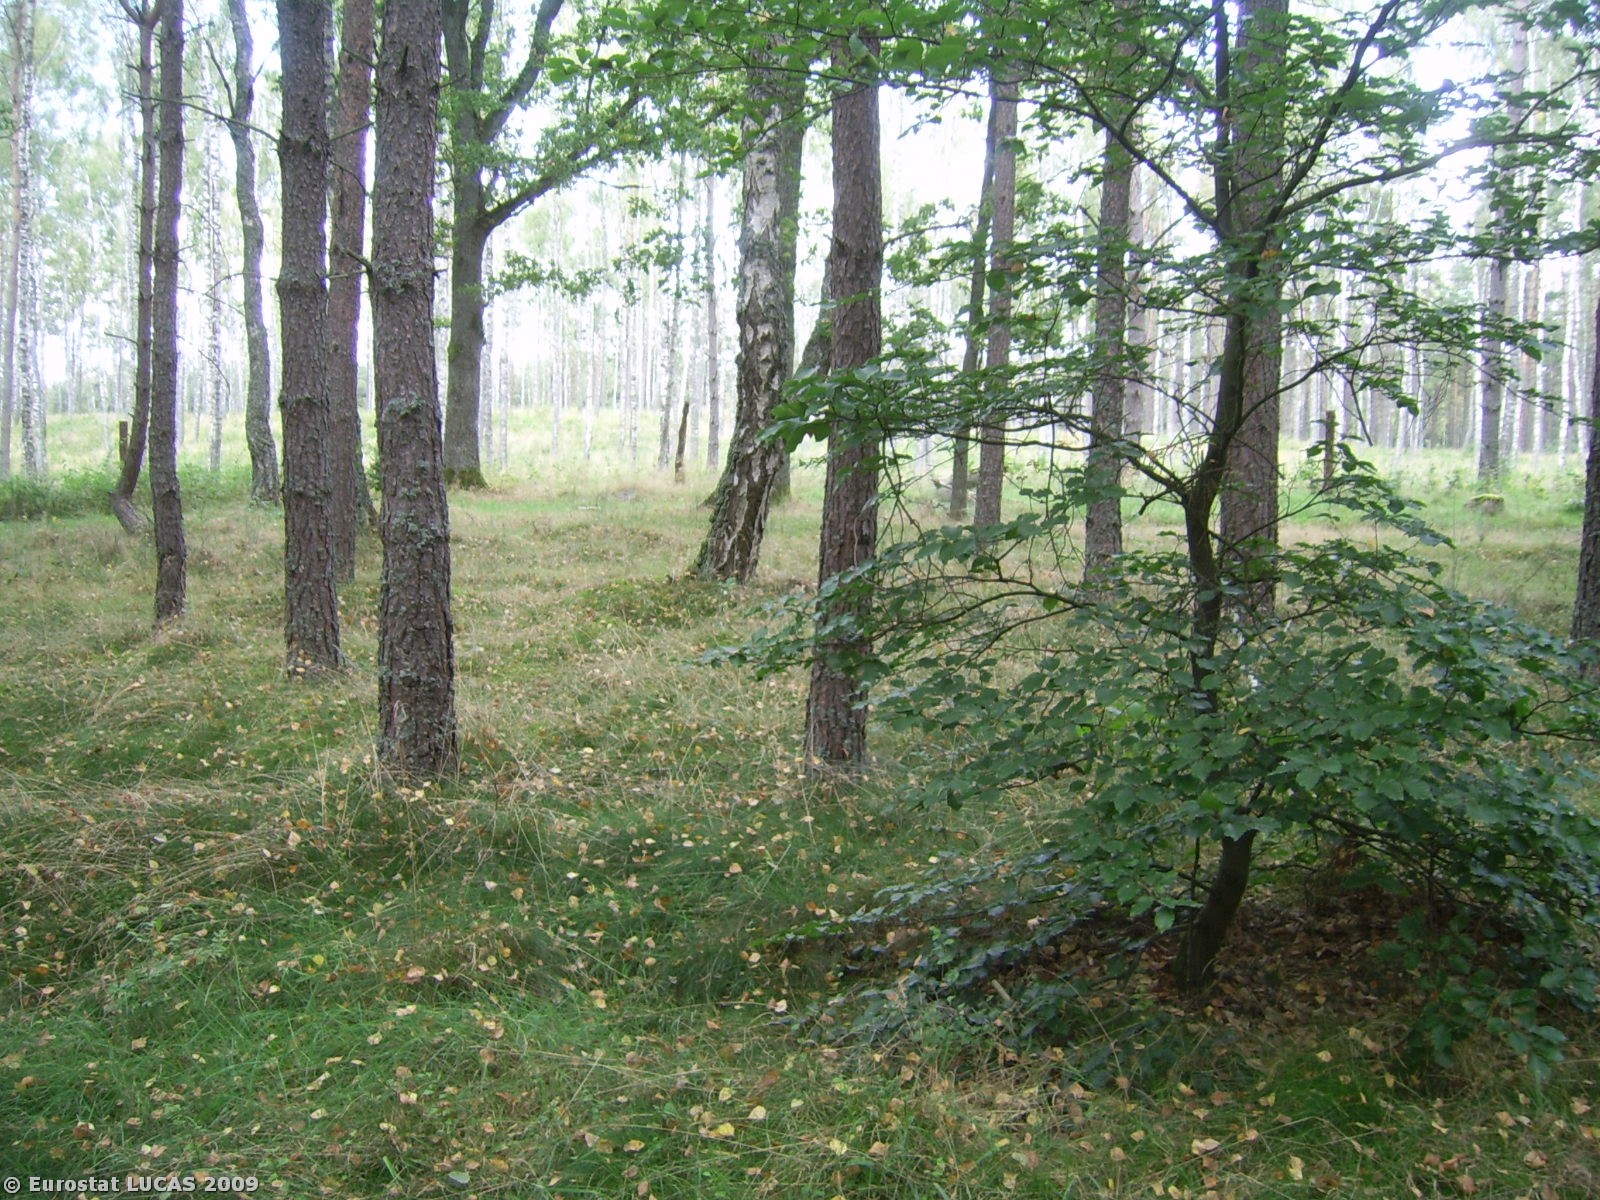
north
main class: Woodland
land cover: Mixed woodland
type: hemiboreal forest and nemoral coniferous forest and mixed broadleaved-coniferous forest
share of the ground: 50 - 75 %
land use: Unused
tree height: > 5 m
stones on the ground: < 10 %
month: September
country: PL
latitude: 53.6682
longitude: 16.3478
